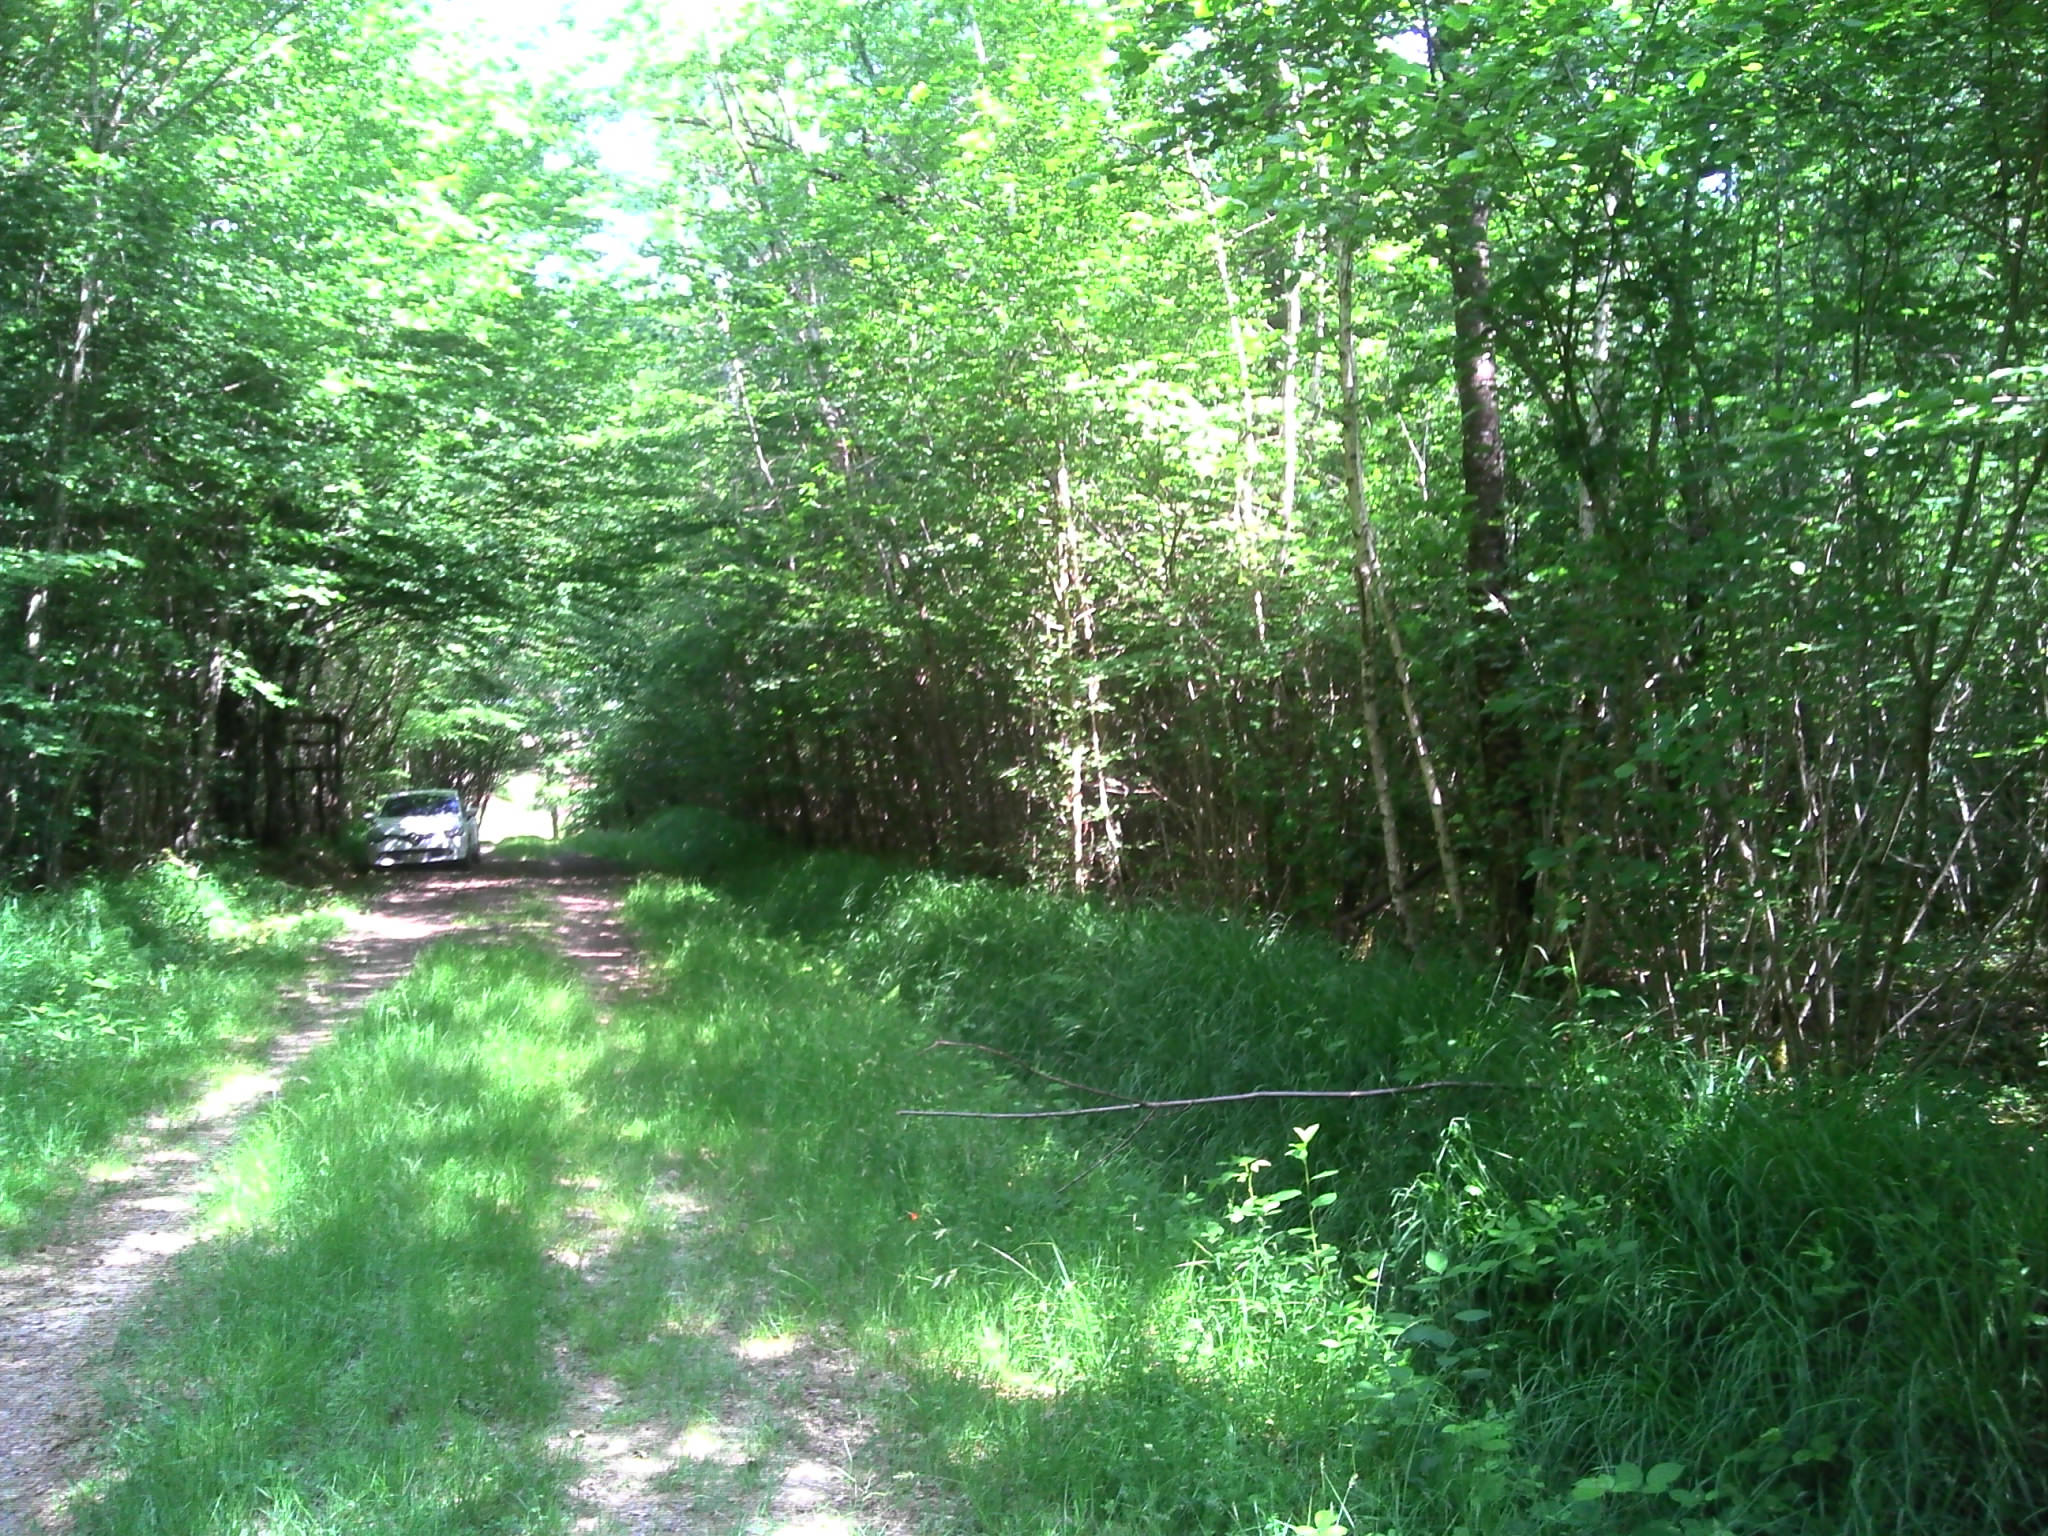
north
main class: Woodland
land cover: Broadleaved woodland
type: mesophytic deciduous forest
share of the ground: > 75 %
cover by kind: broadleaved forest trees 80 %, herbaceous plants 20 %
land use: Forestry
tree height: > 5 m
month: May
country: FR
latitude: 46.5654
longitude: 5.1360
